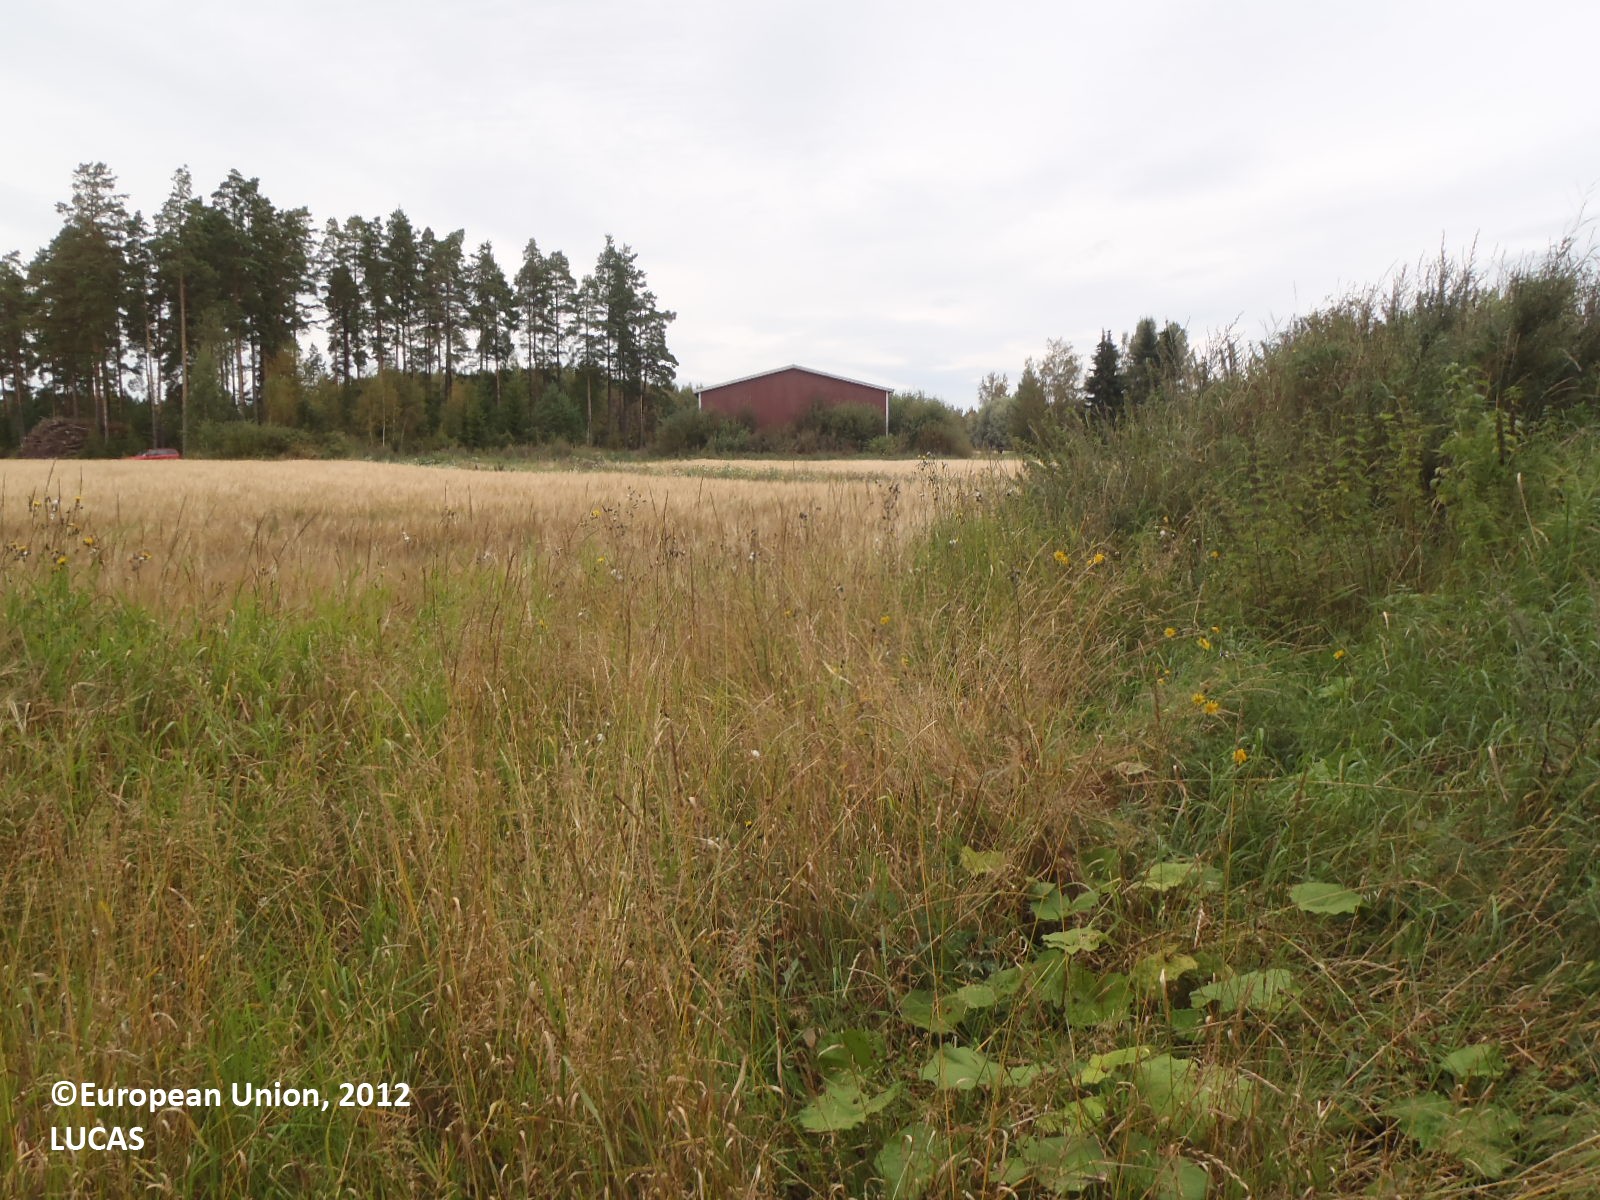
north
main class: Cropland
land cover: Barley
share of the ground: > 75 %
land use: Agriculture (excluding fallow land and kitchen gardens)
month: September
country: FI
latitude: 61.1401
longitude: 22.2649
